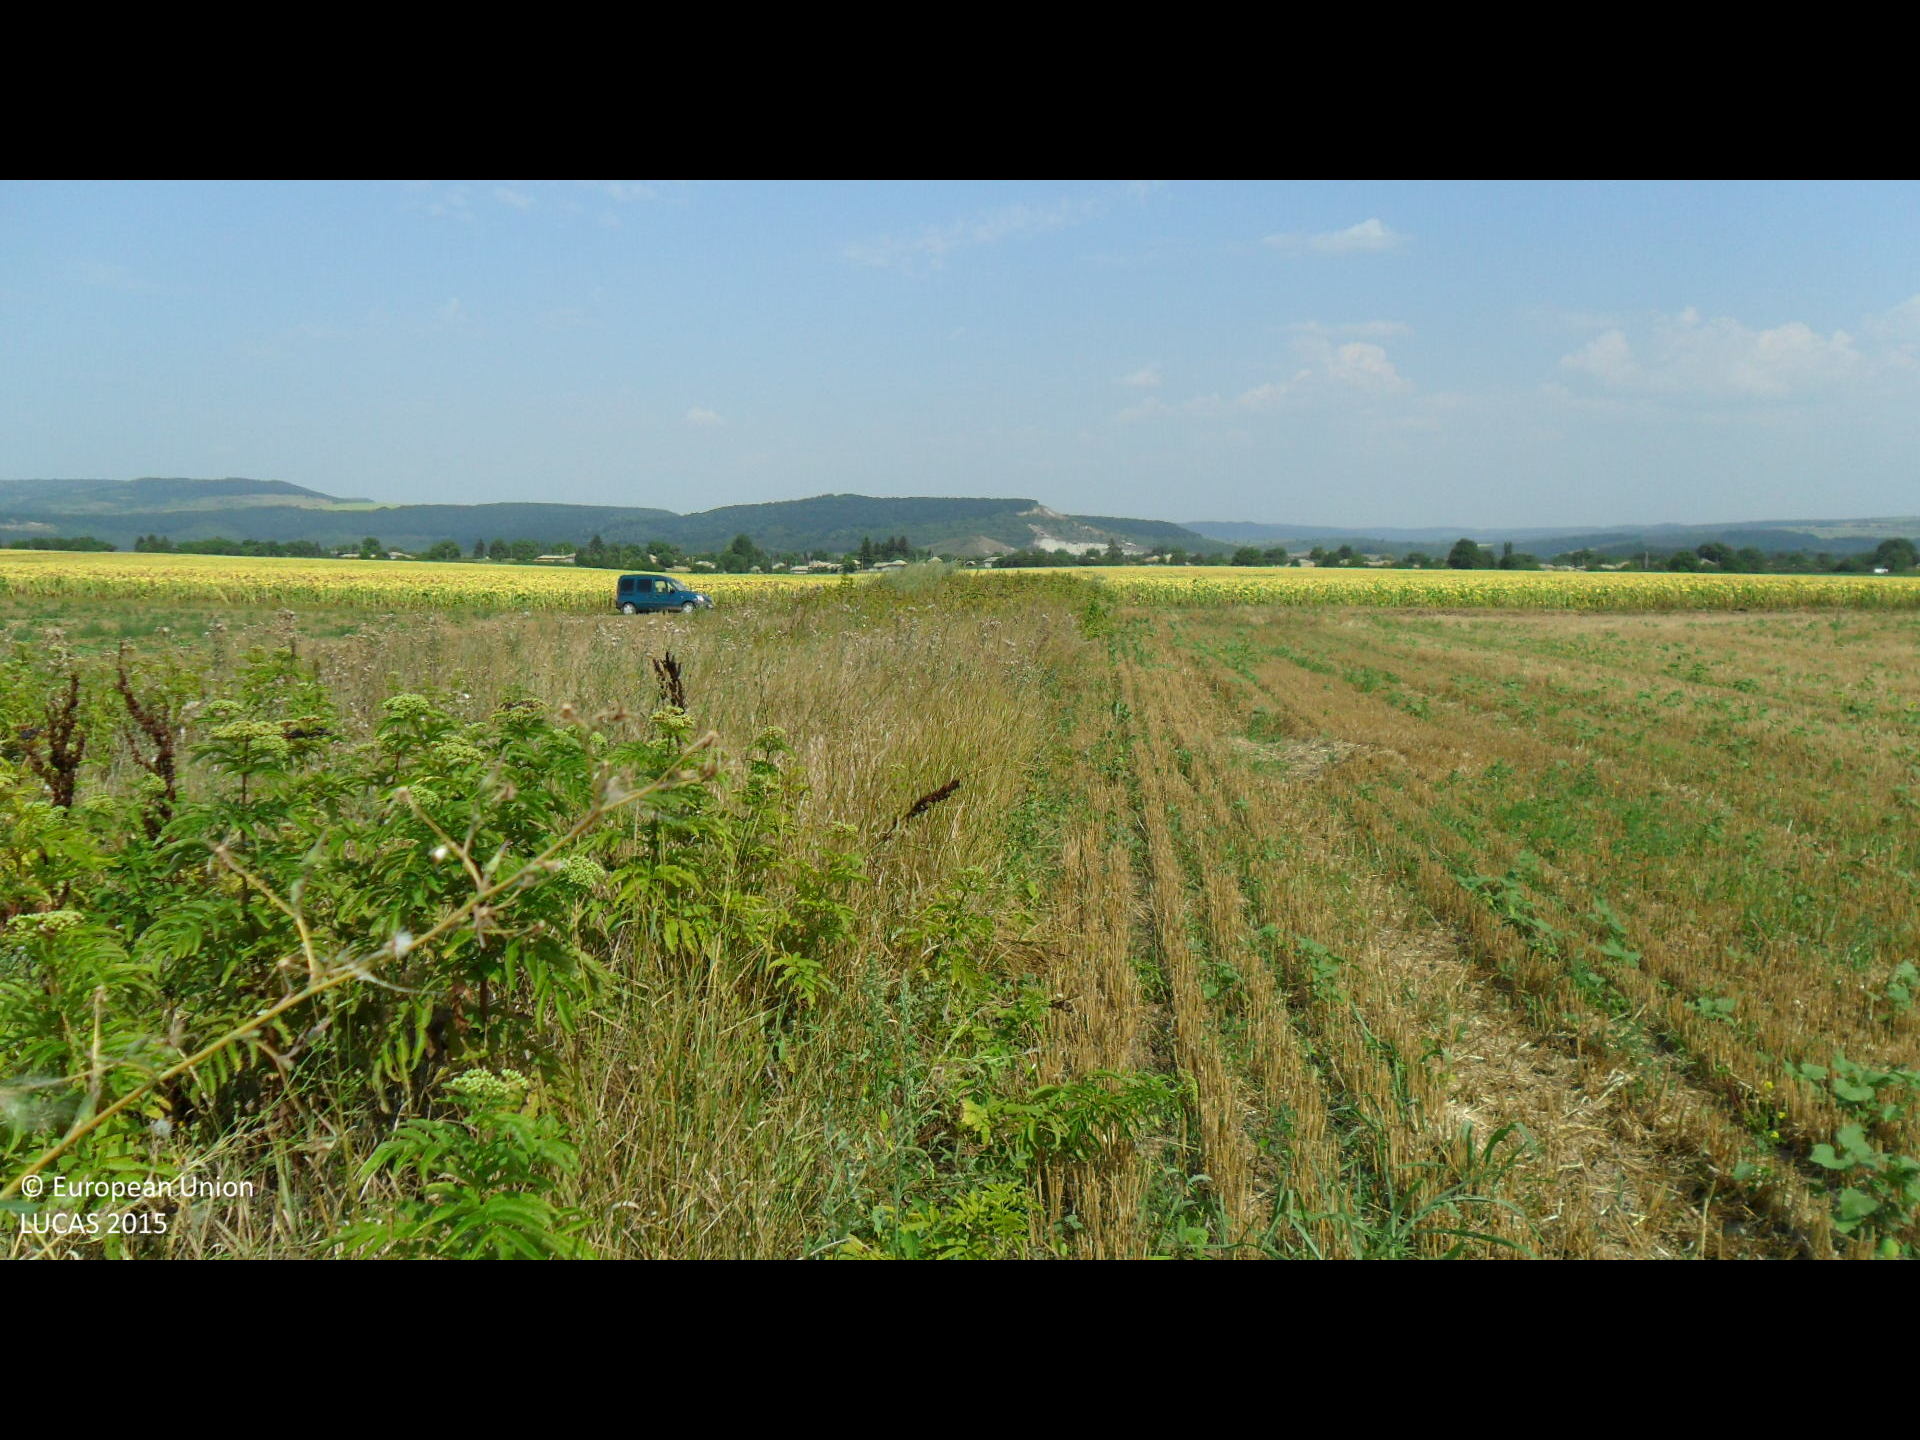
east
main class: Grassland
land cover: Spontaneously vegetated surfaces
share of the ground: > 75 %
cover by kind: herbaceous plants 100 %
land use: Semi-natural and natural areas not in use
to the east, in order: Spontaneously vegetated surfaces; Tracks; Sunflower
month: August
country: BG
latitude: 43.3147
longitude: 26.2611
